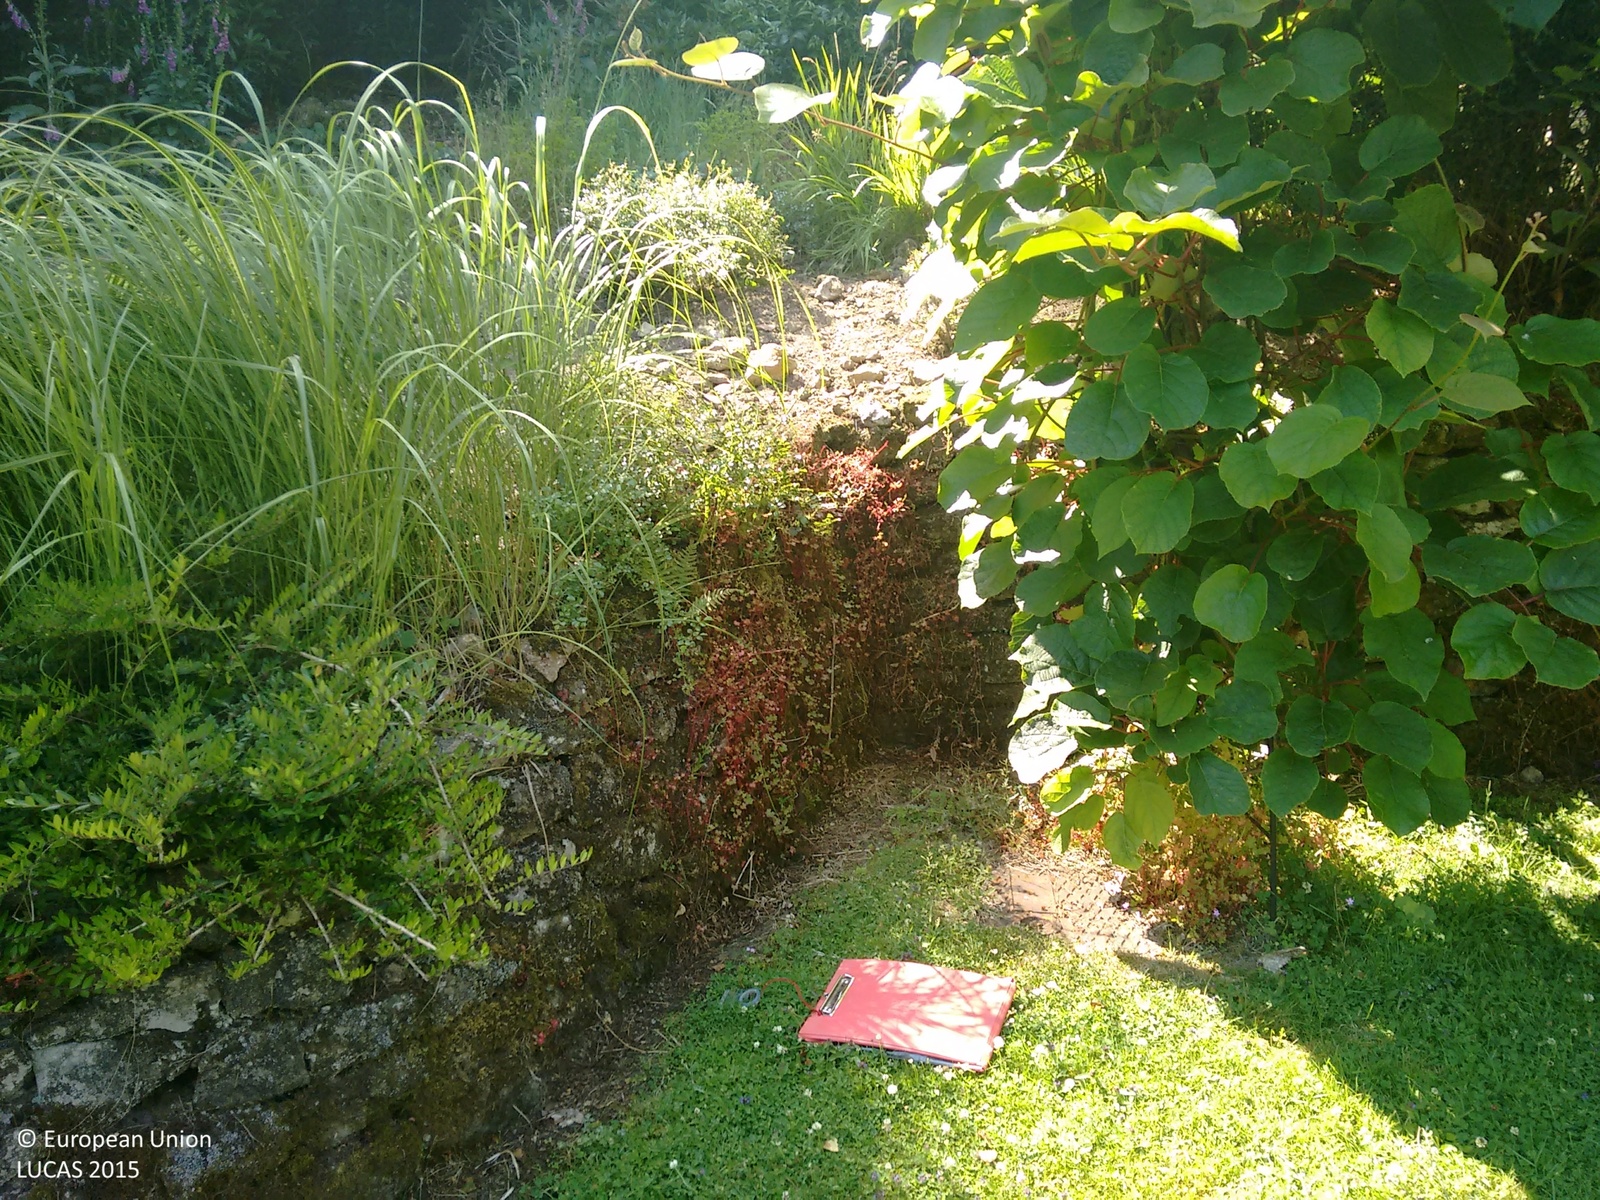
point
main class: Grassland
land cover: Grassland with sparse tree/shrub cover
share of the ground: > 75 %
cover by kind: herbaceous plants 95 %, broadleaved forest trees 5 %
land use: Residential
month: July
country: GB
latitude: 51.1702
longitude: -0.4643
